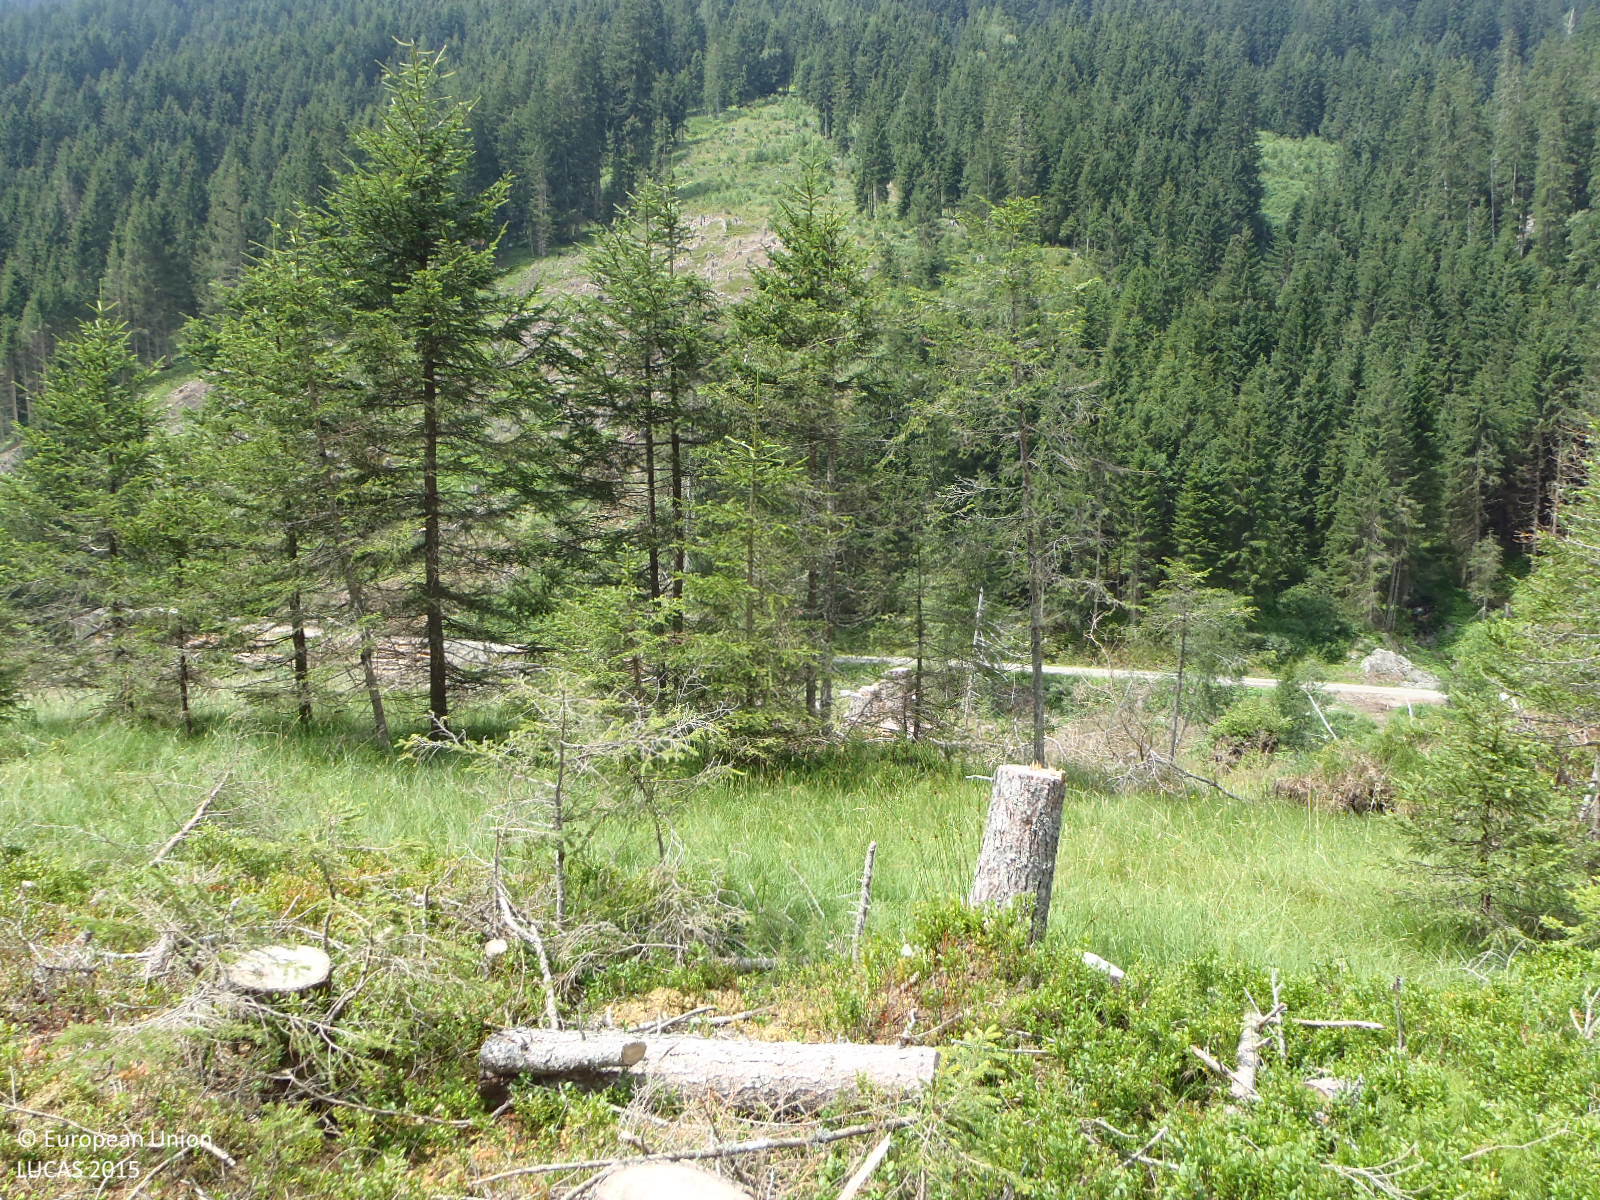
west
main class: Woodland
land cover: Spruce dominated mixed woodland
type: alpine coniferous forest
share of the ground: > 75 %
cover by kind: coniferous forest trees 50 %, broadleaved forest trees 25 %, herbaceous plants 25 %
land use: Forestry
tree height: > 5 m
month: July
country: AT
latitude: 47.2910
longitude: 11.7836
